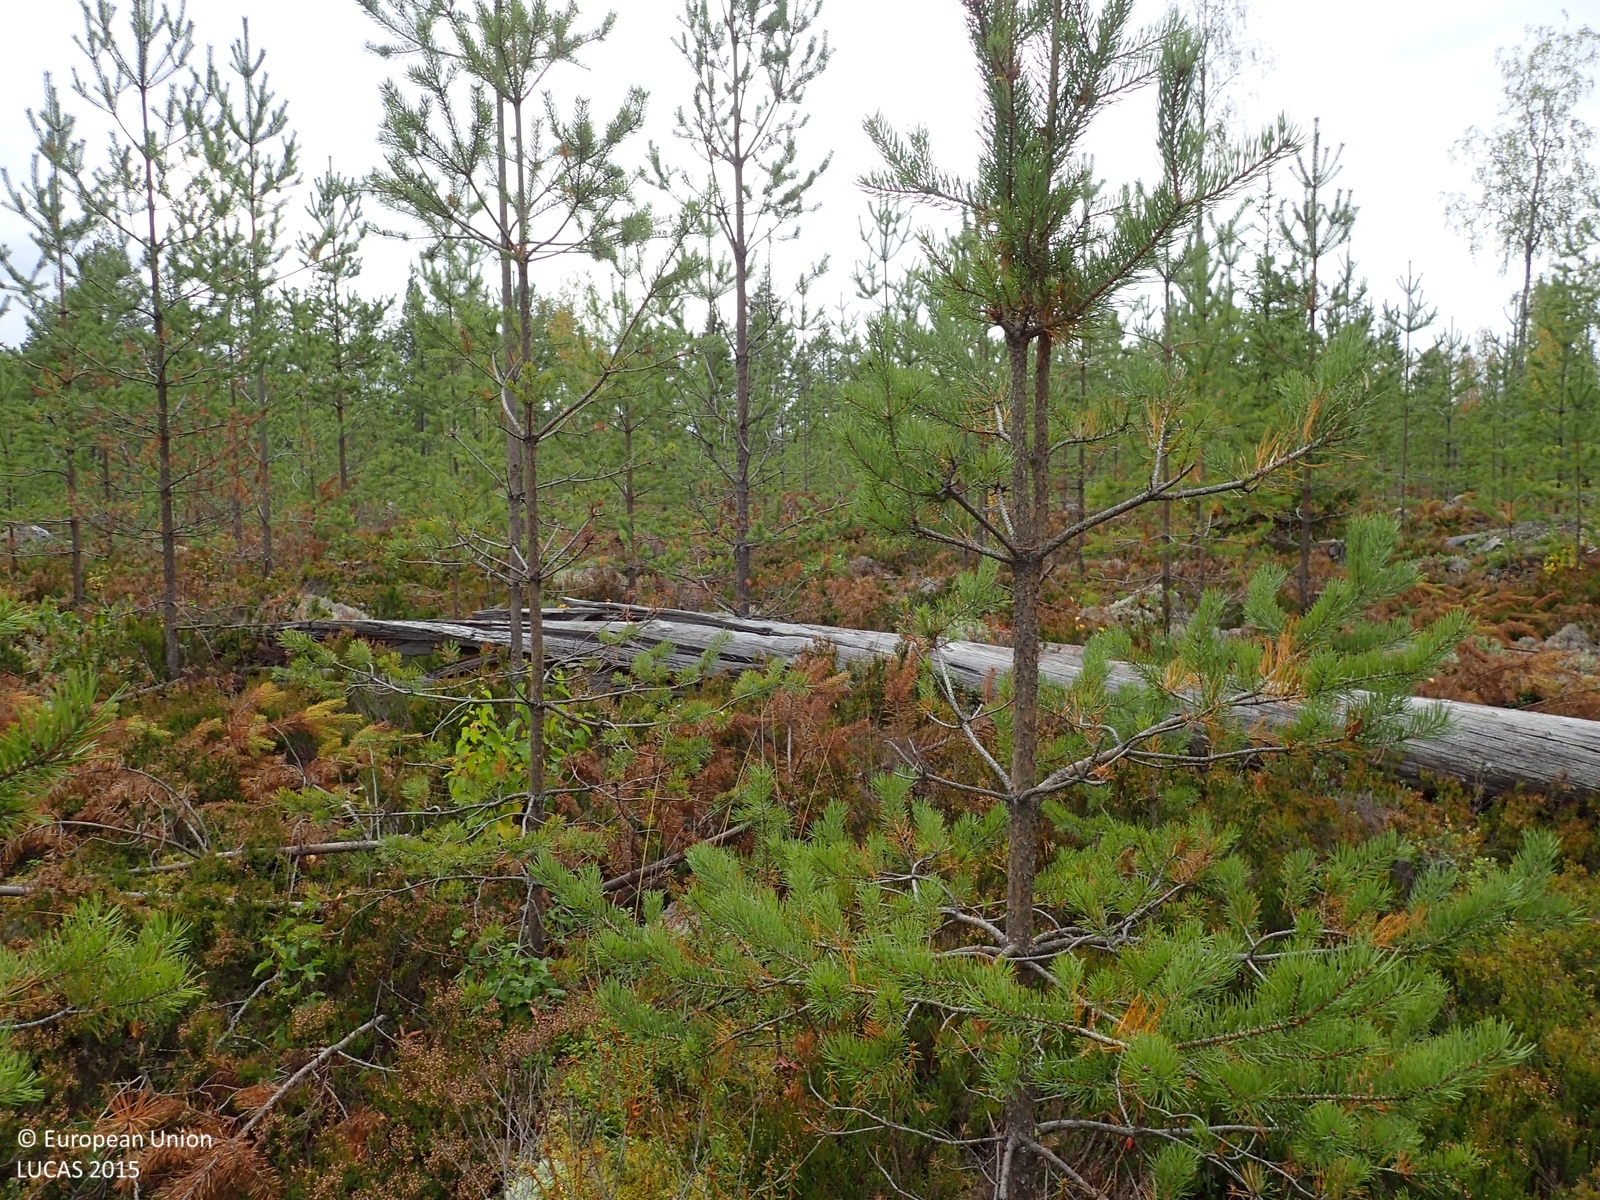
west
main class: Woodland
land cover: Pine dominated coniferous woodland
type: boreal forest
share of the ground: 50 - 75 %
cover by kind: coniferous forest trees 50 %, shrubs 45 %, consolidated bare surface 5 %
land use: Forestry
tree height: < 5 m
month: September
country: FI
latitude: 63.2972
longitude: 25.3186
